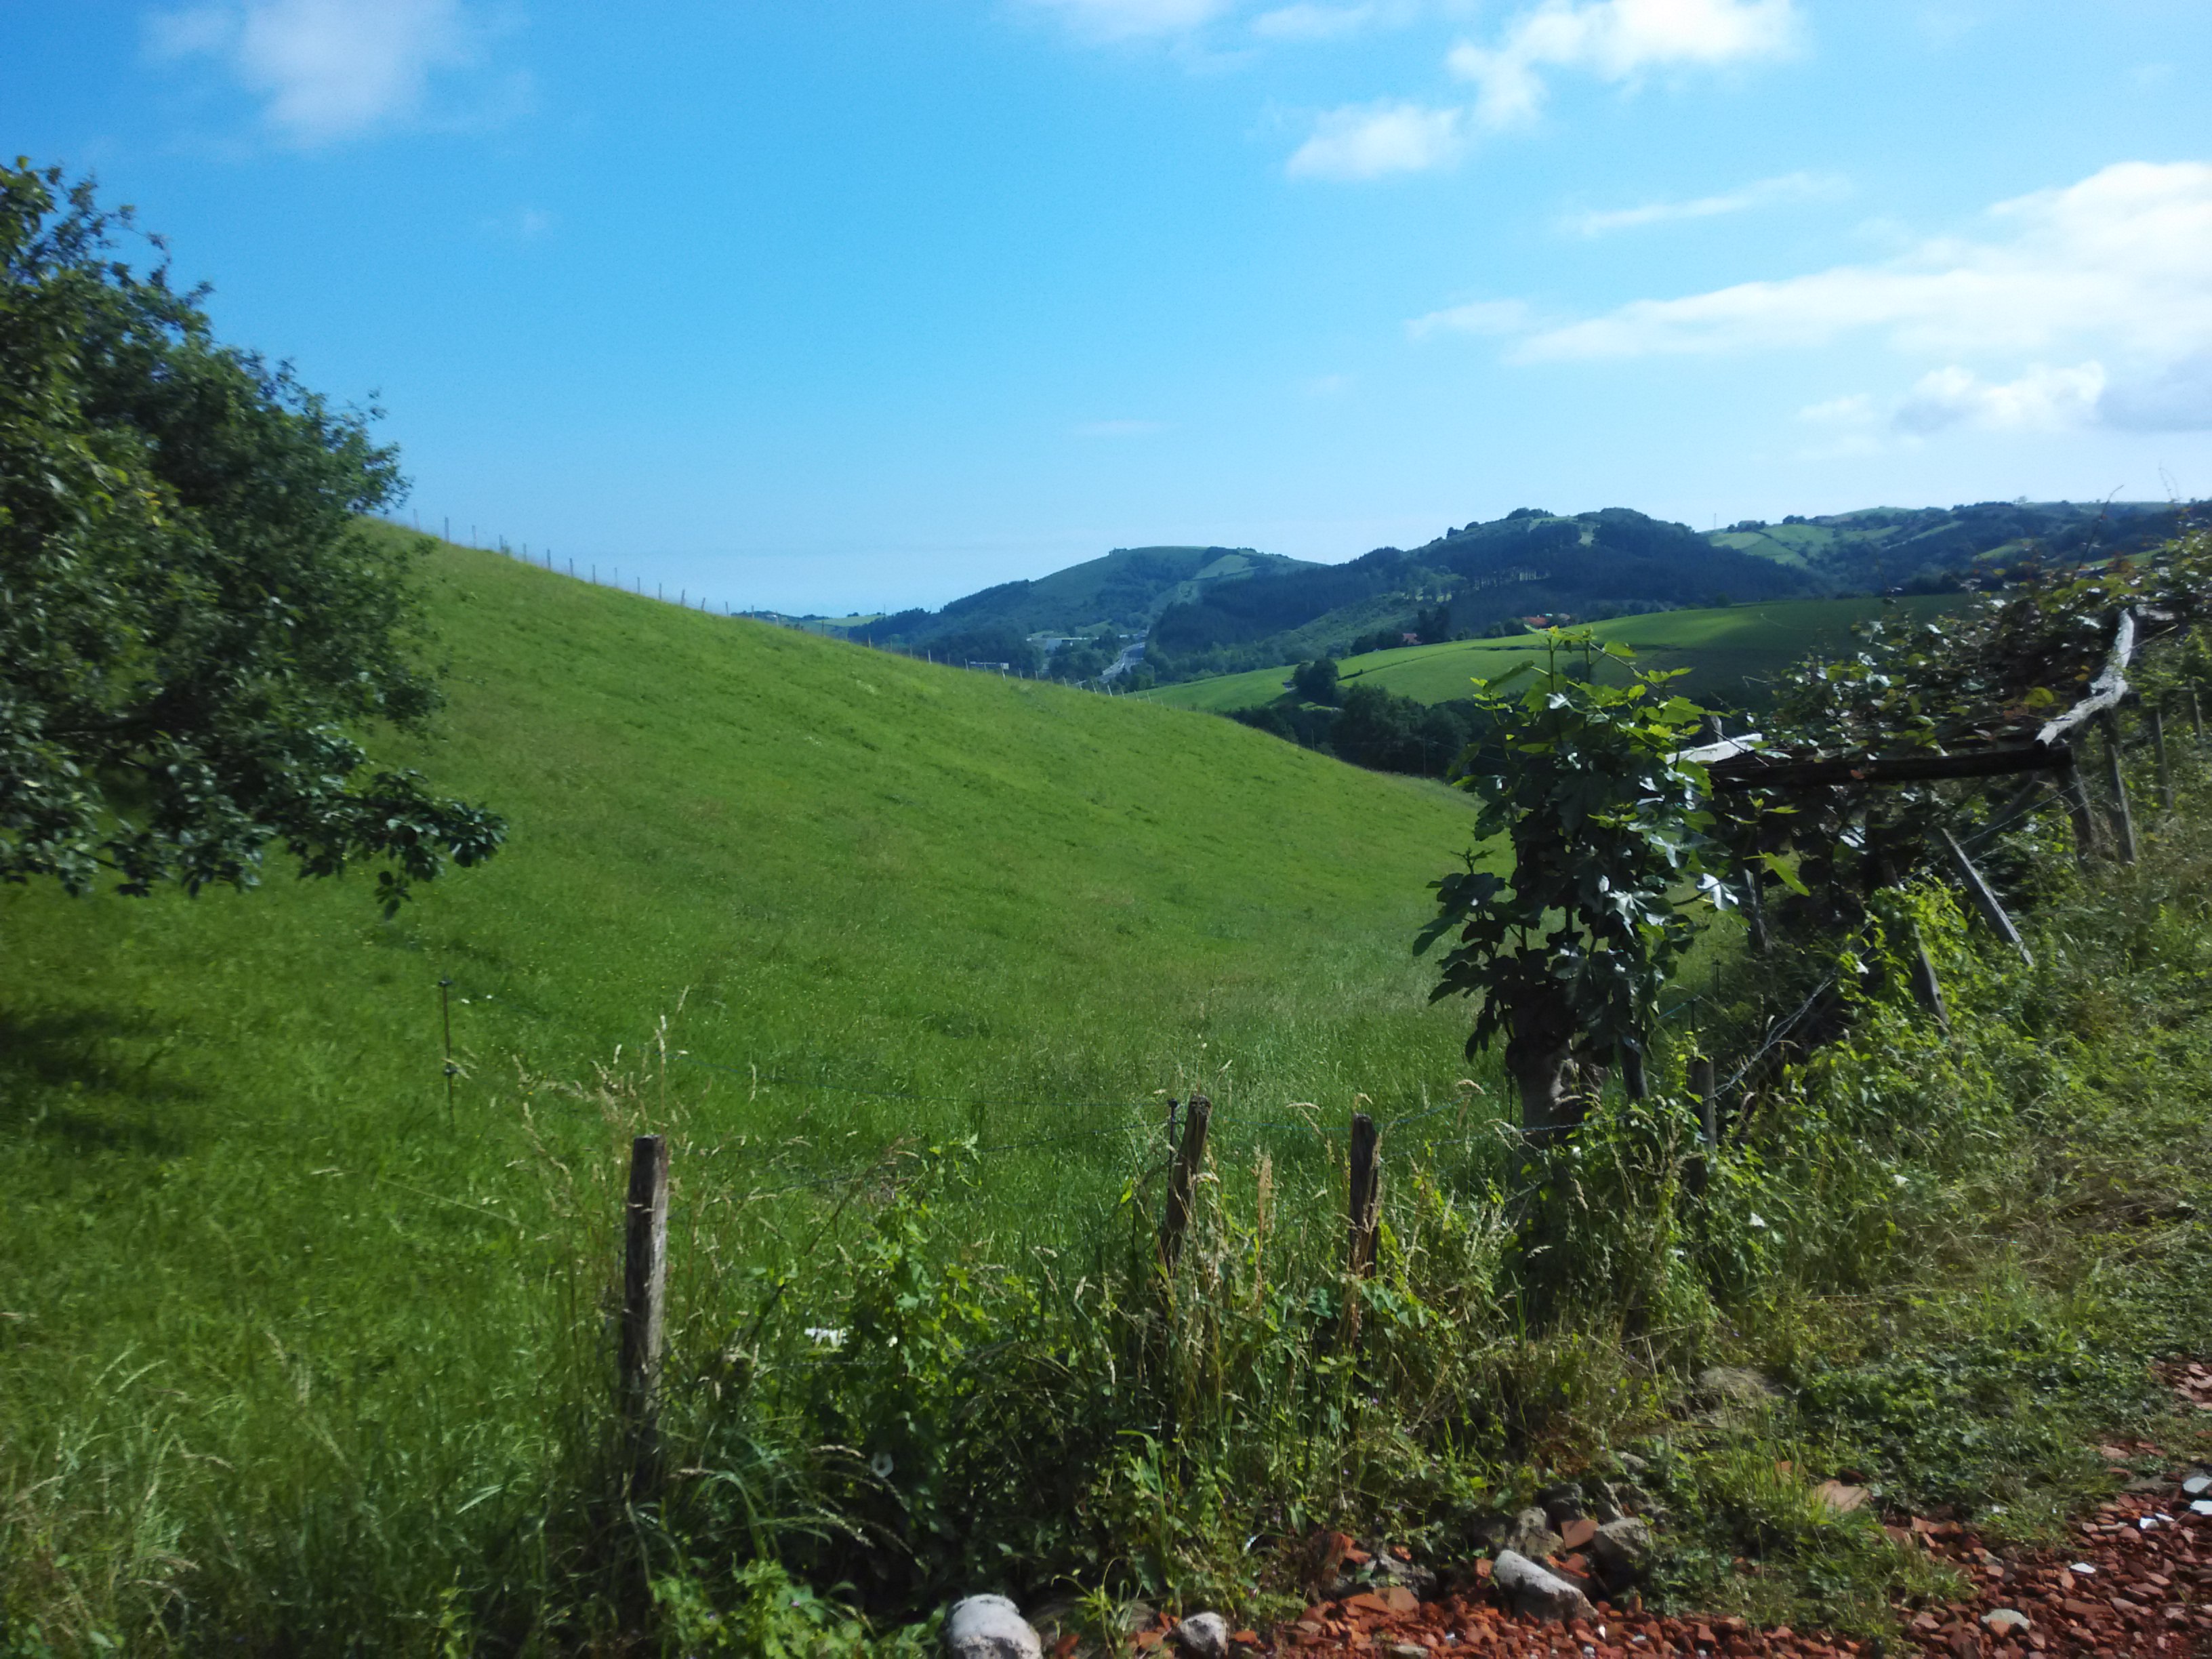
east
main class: Cropland
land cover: Apple fruit
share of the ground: 25 - 50 %
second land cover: Grassland without tree/shrub cover
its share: 50 - 75 %
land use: Agriculture (excluding fallow land and kitchen gardens)
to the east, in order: Apple fruit; Grassland without tree/shrub cover; Fences; Grassland with sparse tree/shrub cover; Electric lines; Fences; Apple fruit; Fences; Apple fruit; Fences; Apple fruit; Fences; Tracks; Broadleaved woodland; Tracks; Grassland without tree/shrub cover; Broadleaved woodland; Grassland without tree/shrub cover
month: June
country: ES
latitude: 43.2534
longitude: -2.2814
